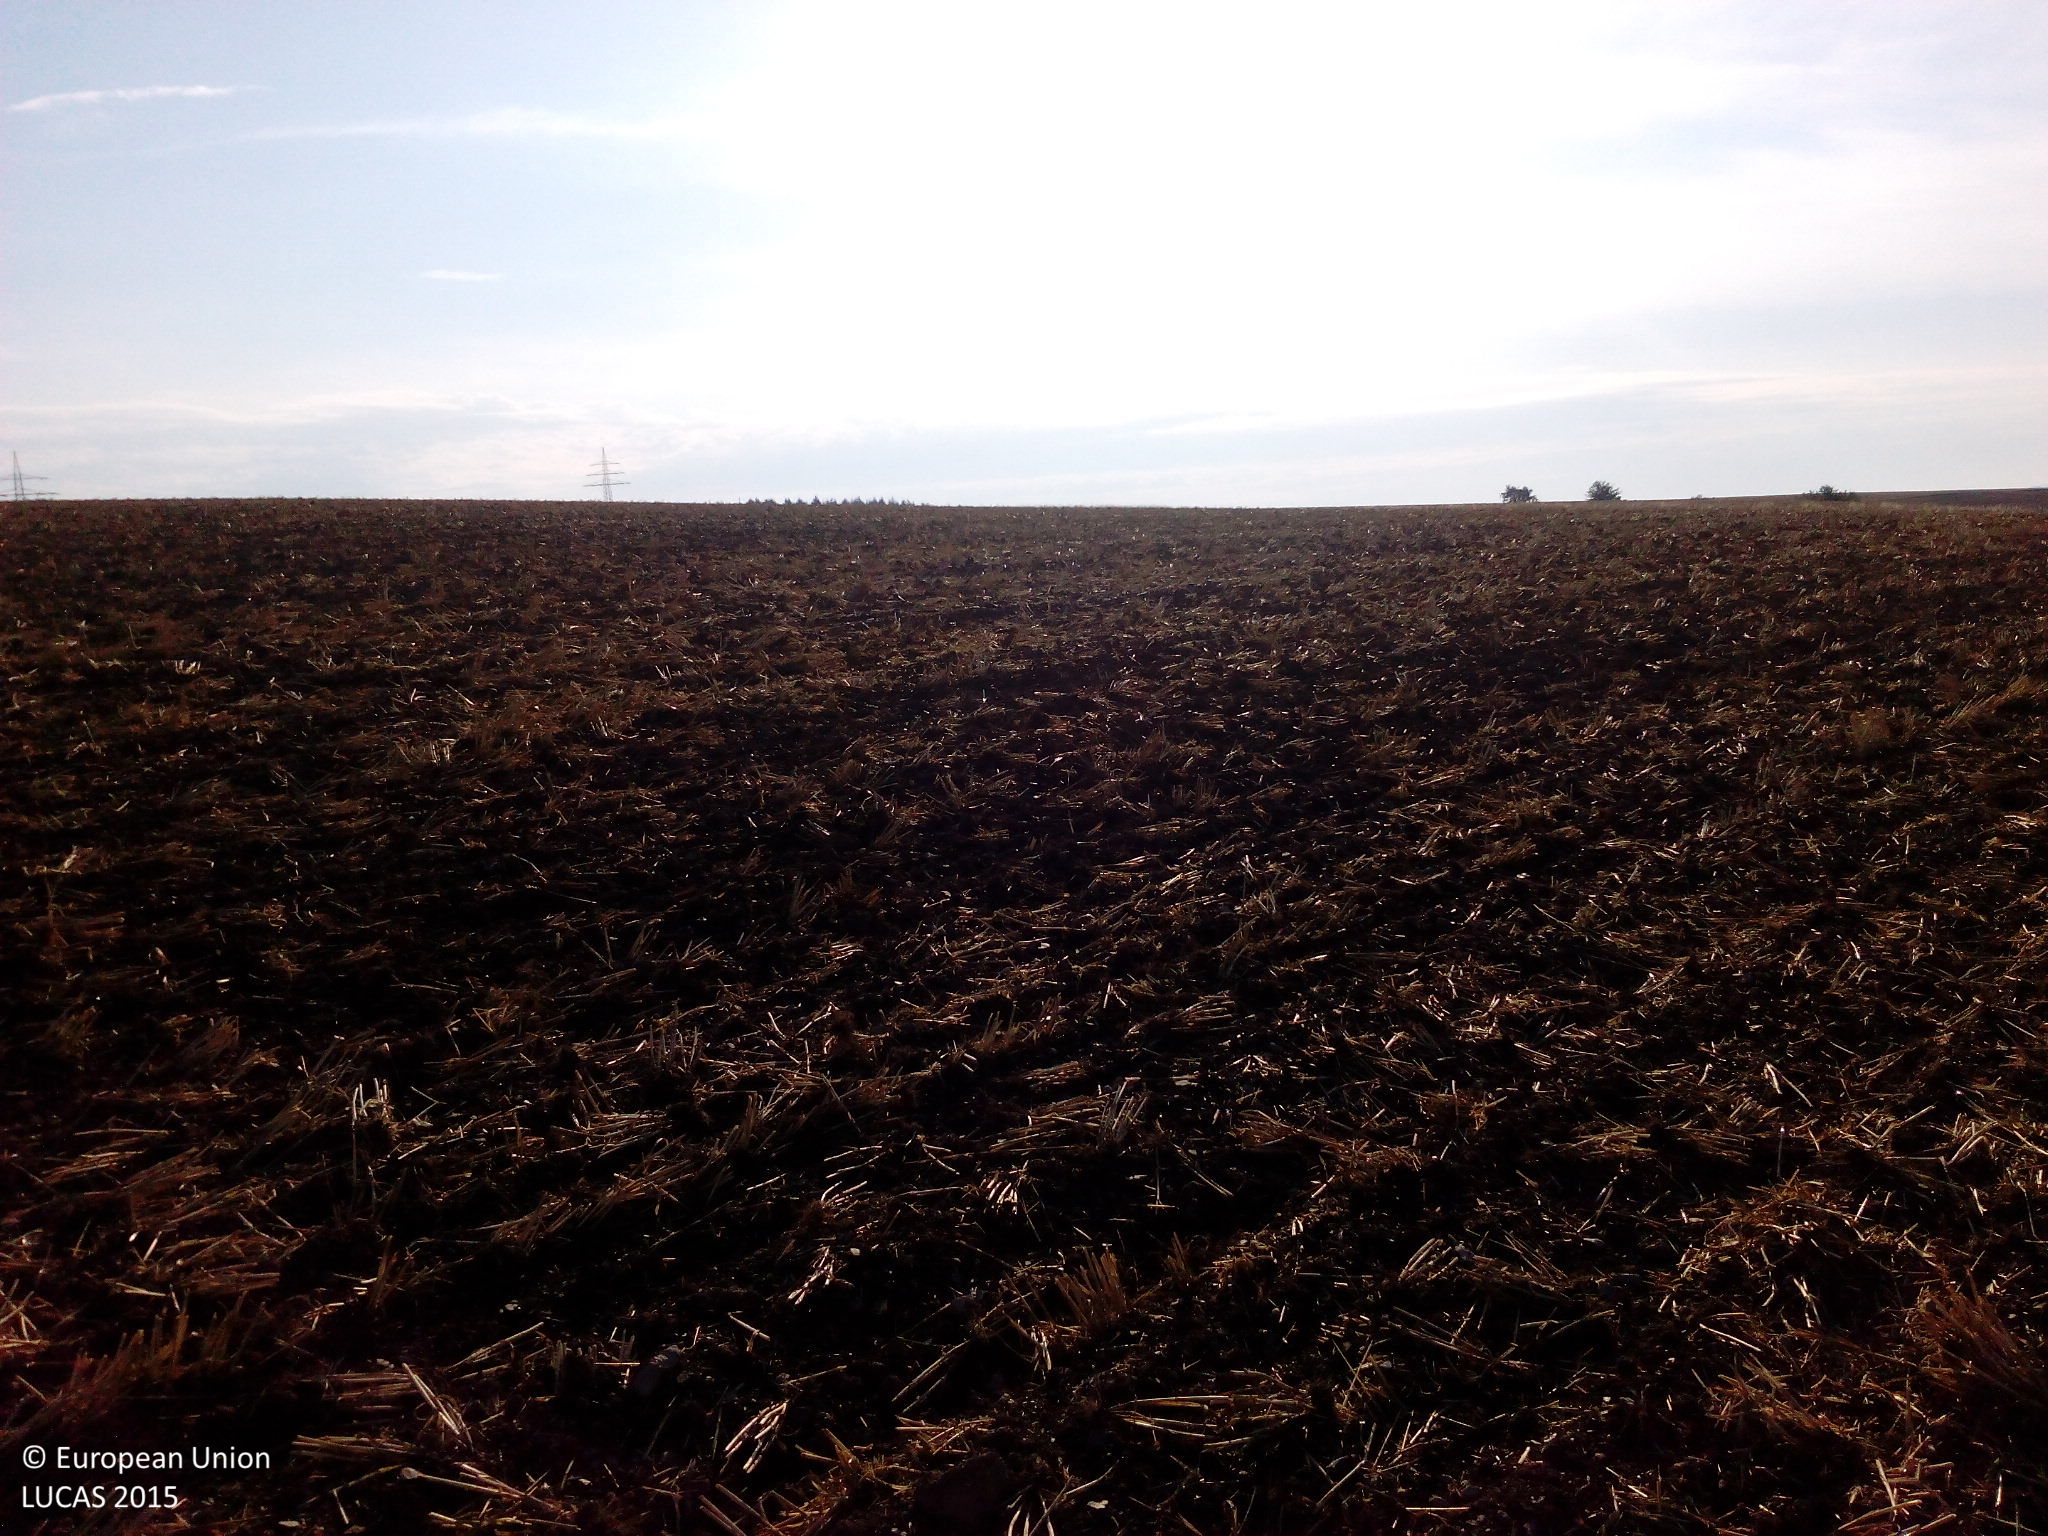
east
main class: Cropland
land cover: Common wheat
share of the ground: < 10 %
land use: Agriculture (excluding fallow land and kitchen gardens)
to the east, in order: Common wheat; Grassland without tree/shrub cover; Common wheat; Grass margins; Paved roads, cycling and walking lanes; Grass margins; Ditches and canals; Grass margins; Common wheat
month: August
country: DE
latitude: 50.2391
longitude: 8.0234
